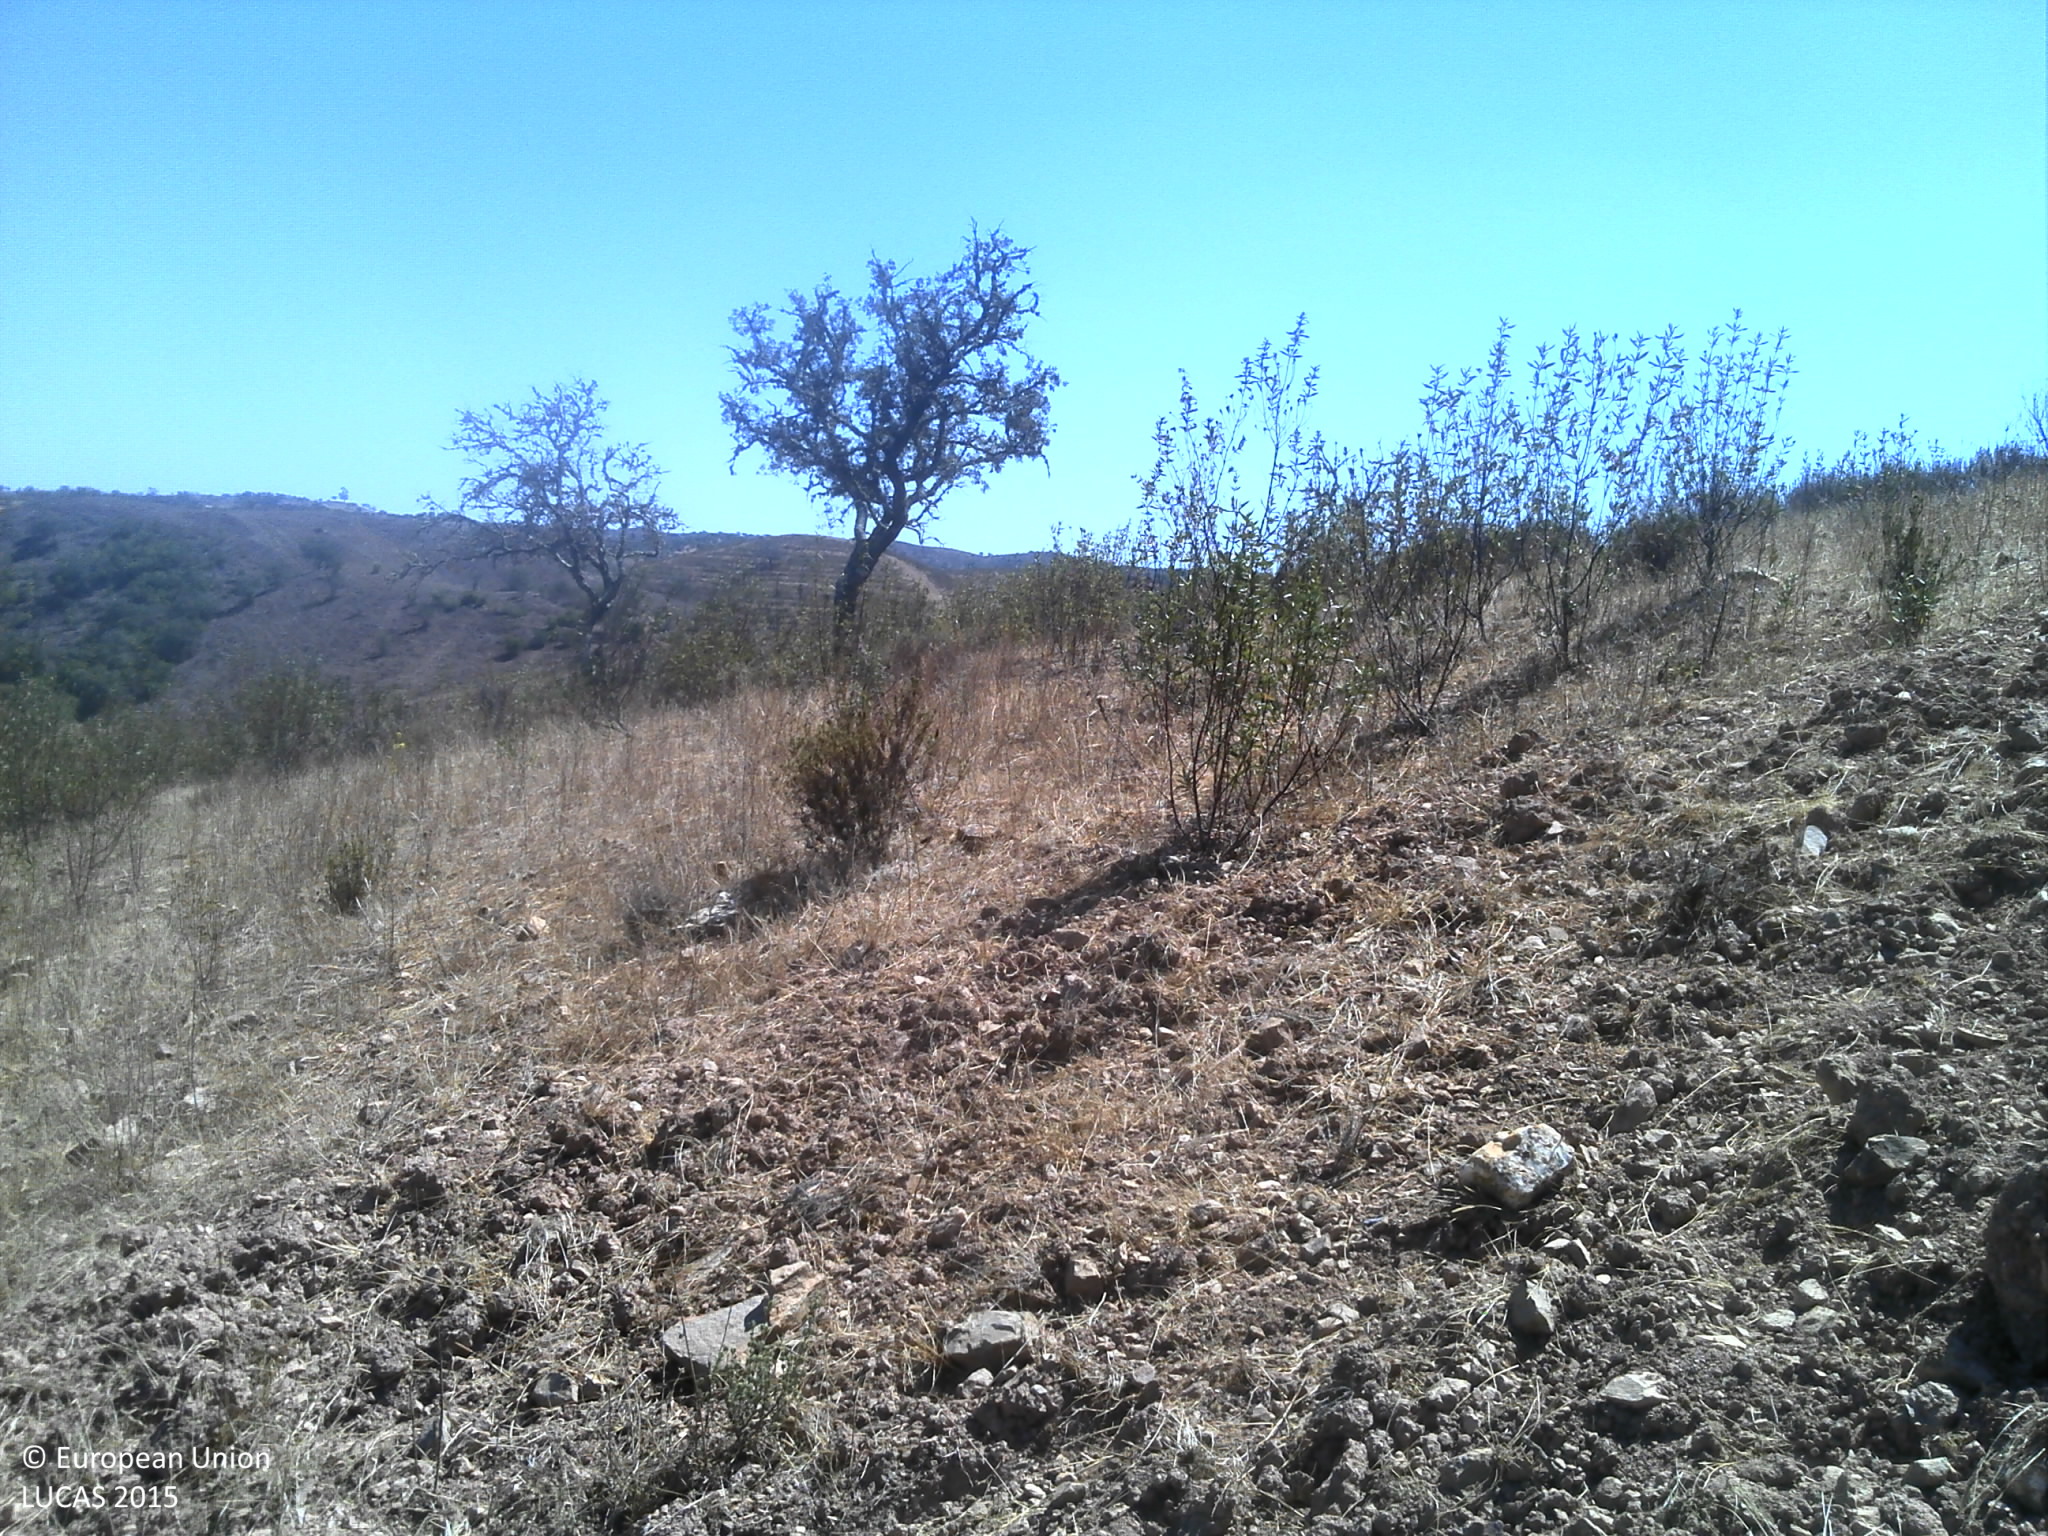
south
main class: Woodland
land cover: Broadleaved woodland
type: broadleaved evergreen forest
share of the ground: 10 - 25 %
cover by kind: unconsolidated bare surface 70 %, broadleaved forest trees 15 %, shrubs 15 %
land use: Forestry
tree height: < 5 m
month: August
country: PT
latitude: 37.4938
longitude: -8.2011
